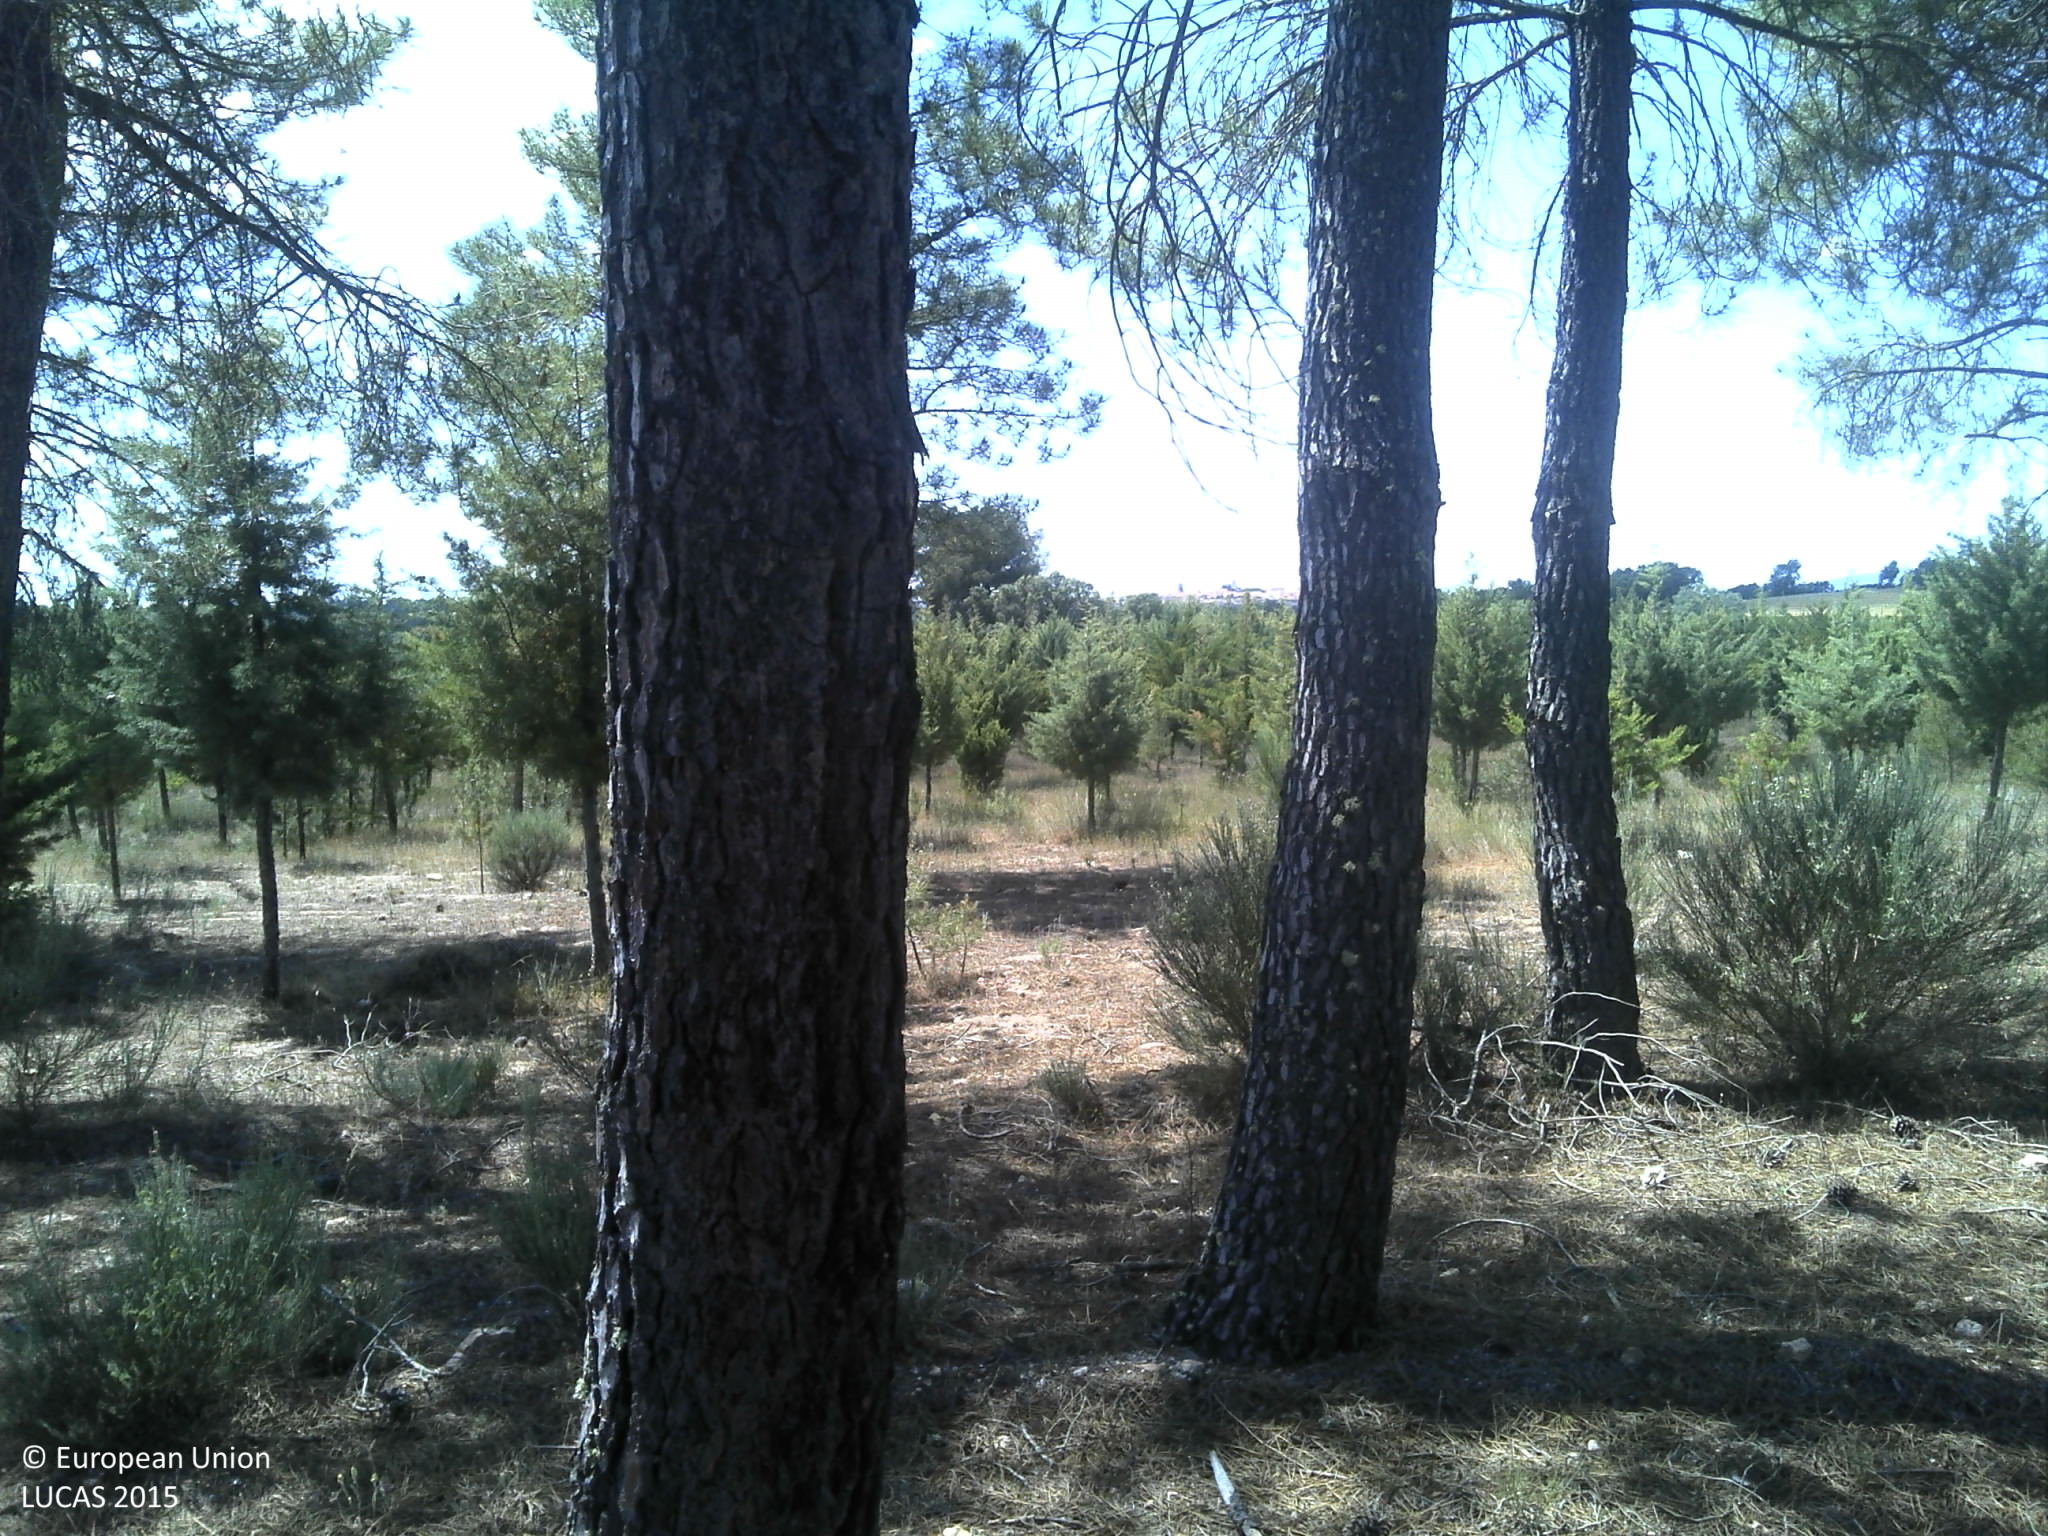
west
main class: Woodland
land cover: Pine dominated coniferous woodland
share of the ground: 50 - 75 %
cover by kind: coniferous forest trees 70 %, unconsolidated bare surface 20 %, shrubs 5 %, herbaceous plants 5 %
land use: Forestry
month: June
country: PT
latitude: 40.7109
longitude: -6.8722
